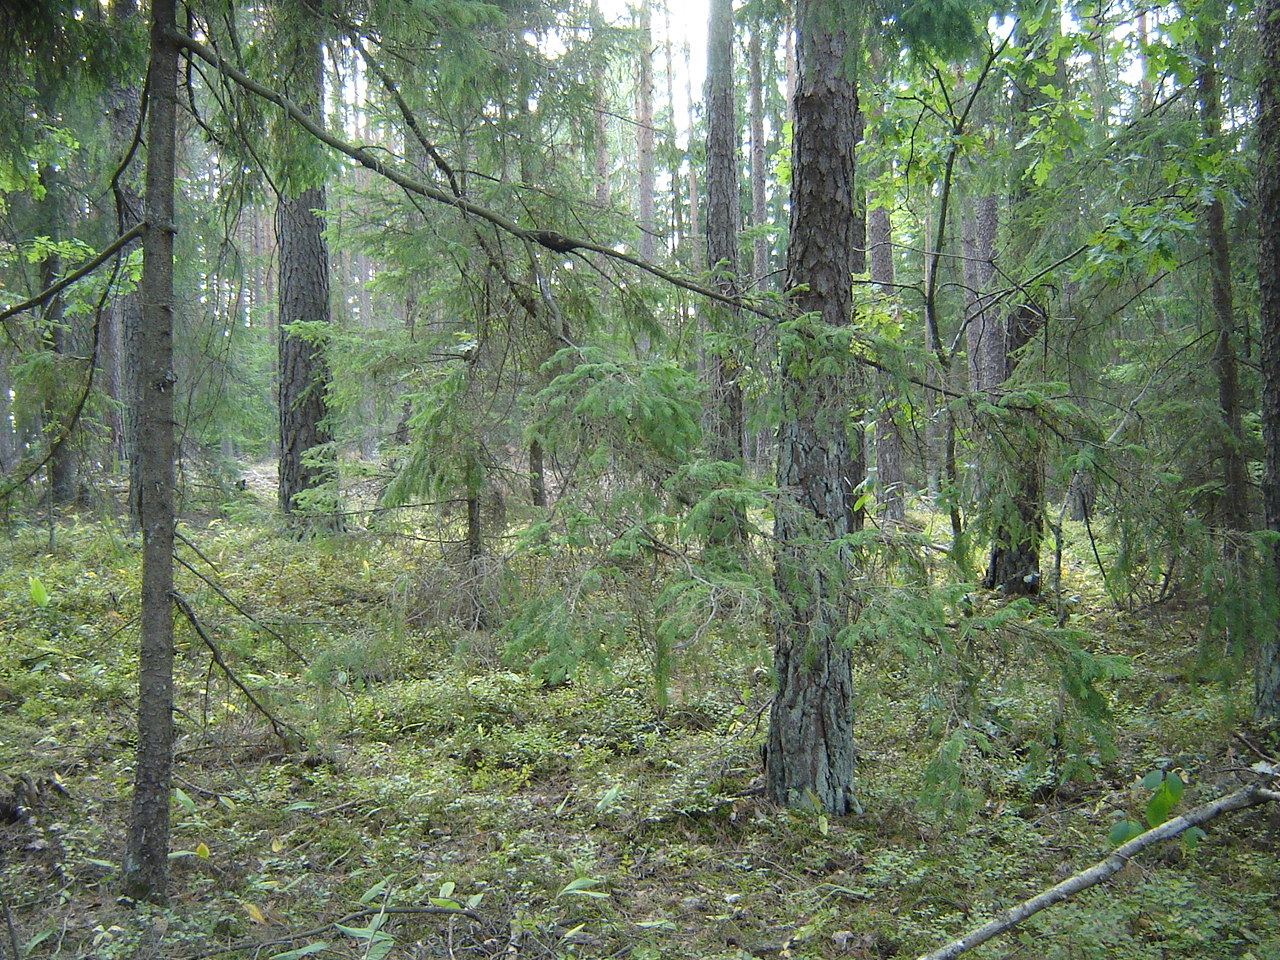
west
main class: Woodland
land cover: Pine dominated coniferous woodland
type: hemiboreal forest and nemoral coniferous forest and mixed broadleaved-coniferous forest
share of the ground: > 75 %
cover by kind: coniferous forest trees 80 %, shrubs 10 %, lichens and mosses 10 %
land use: Forestry
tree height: > 5 m
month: August
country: LT
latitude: 54.7835
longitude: 24.8672
